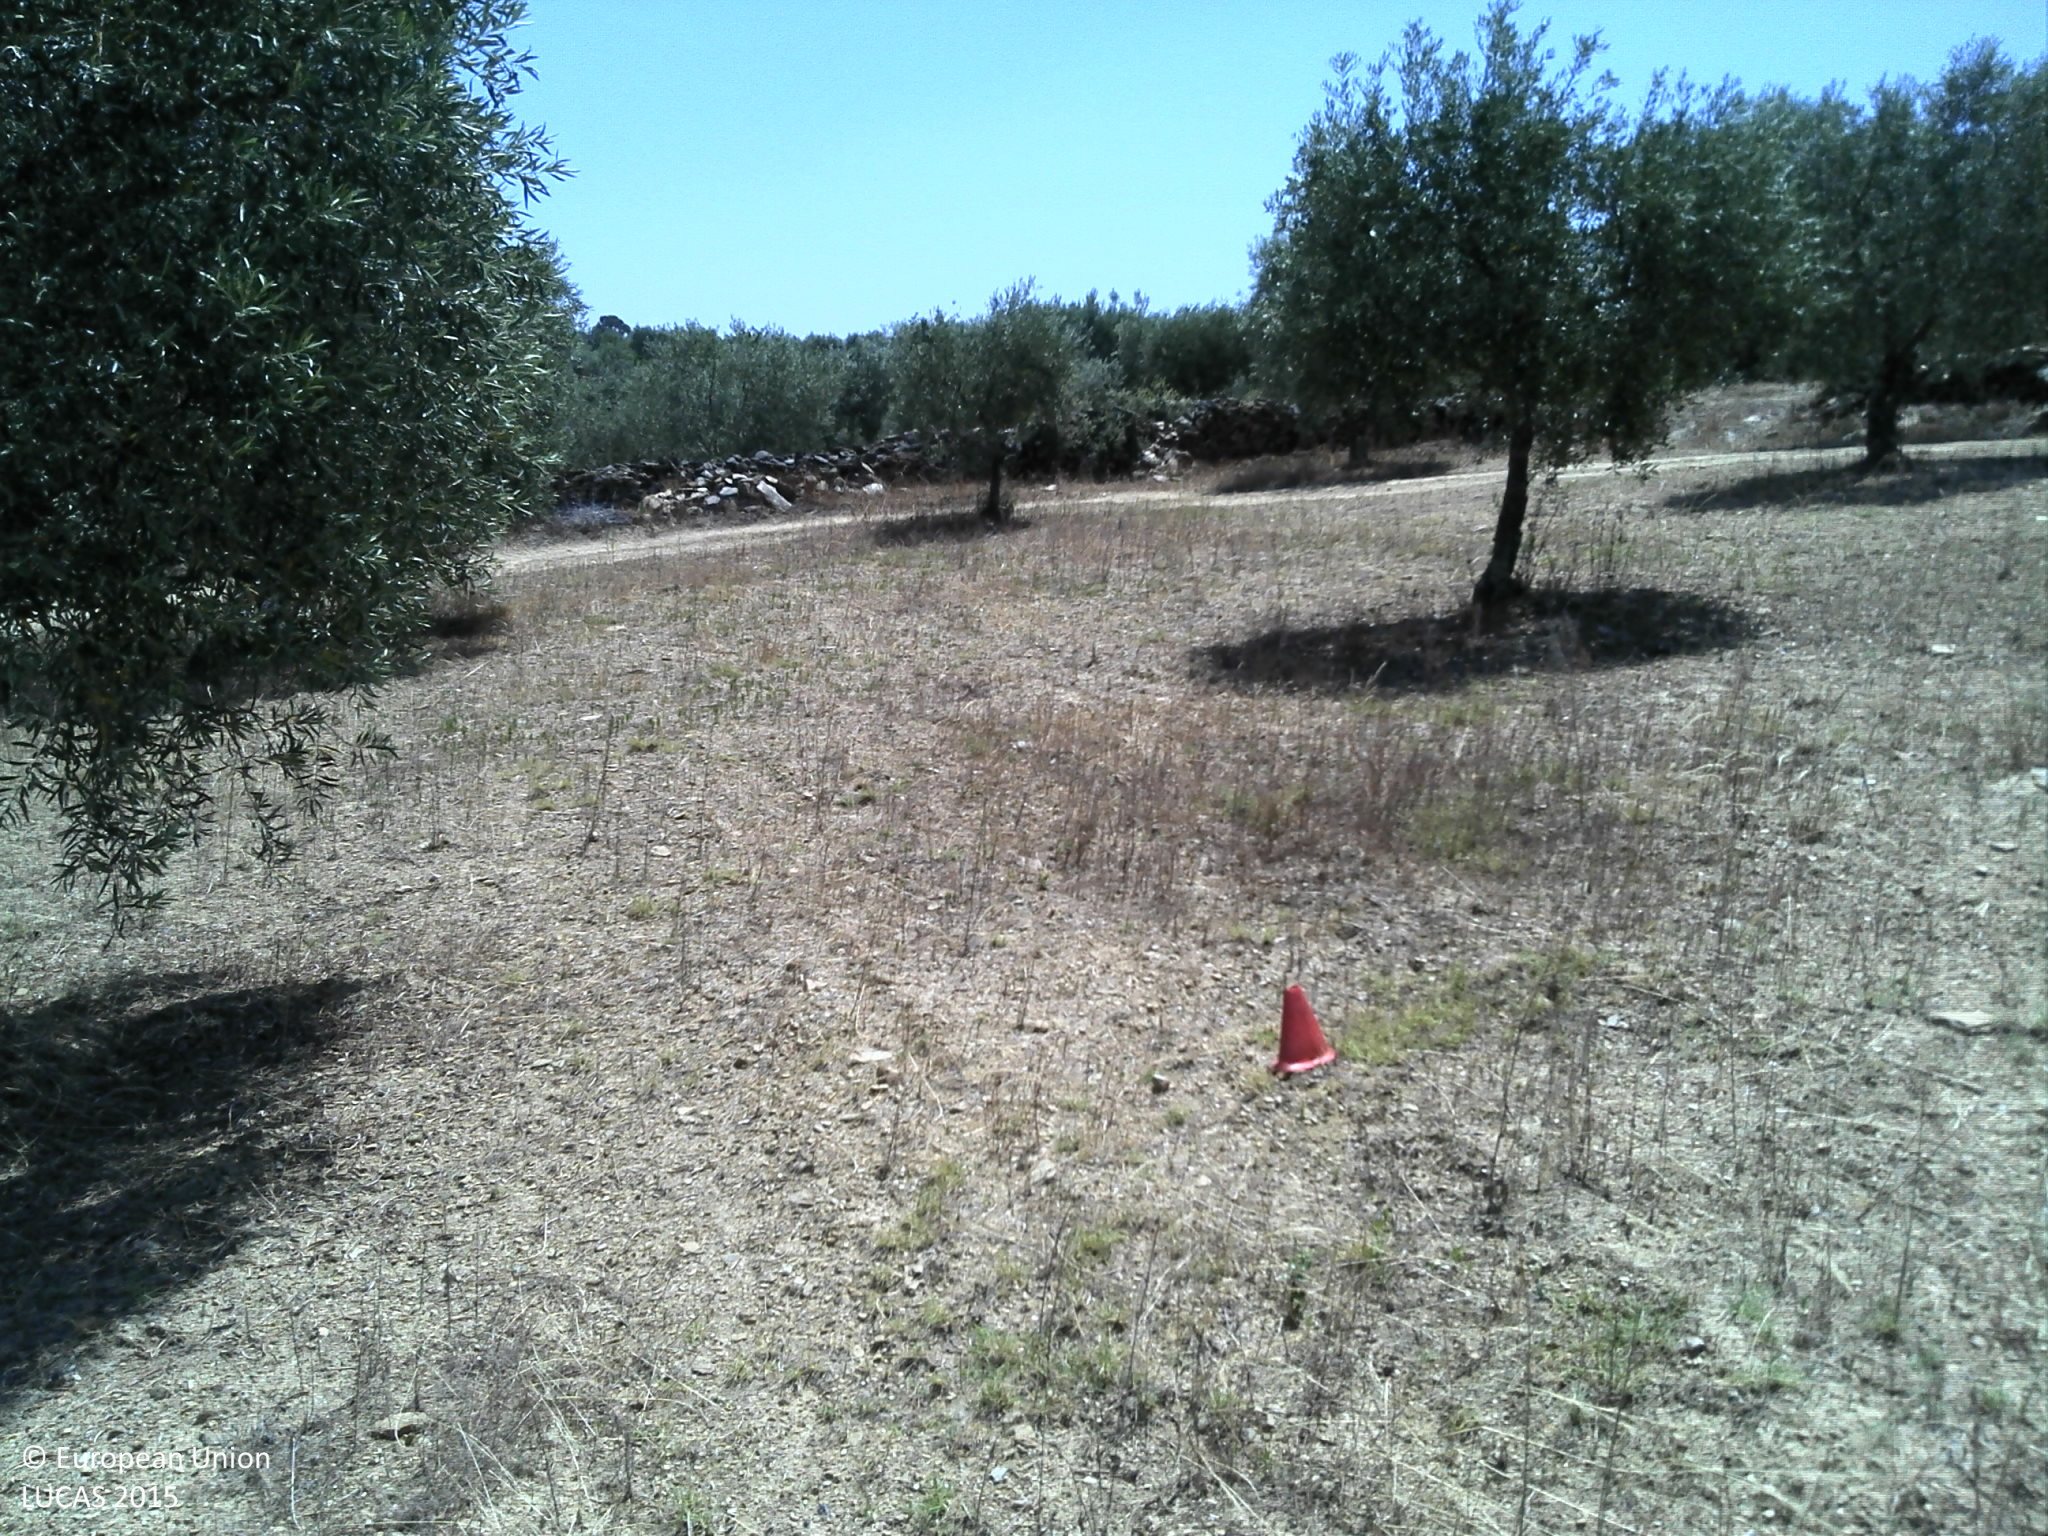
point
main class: Cropland
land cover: Olive groves
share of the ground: 25 - 50 %
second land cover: Grassland without tree/shrub cover
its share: < 10 %
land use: Agriculture (excluding fallow land and kitchen gardens)
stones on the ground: 10 - 25 %
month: July
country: PT
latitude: 41.0902
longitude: -7.4406
